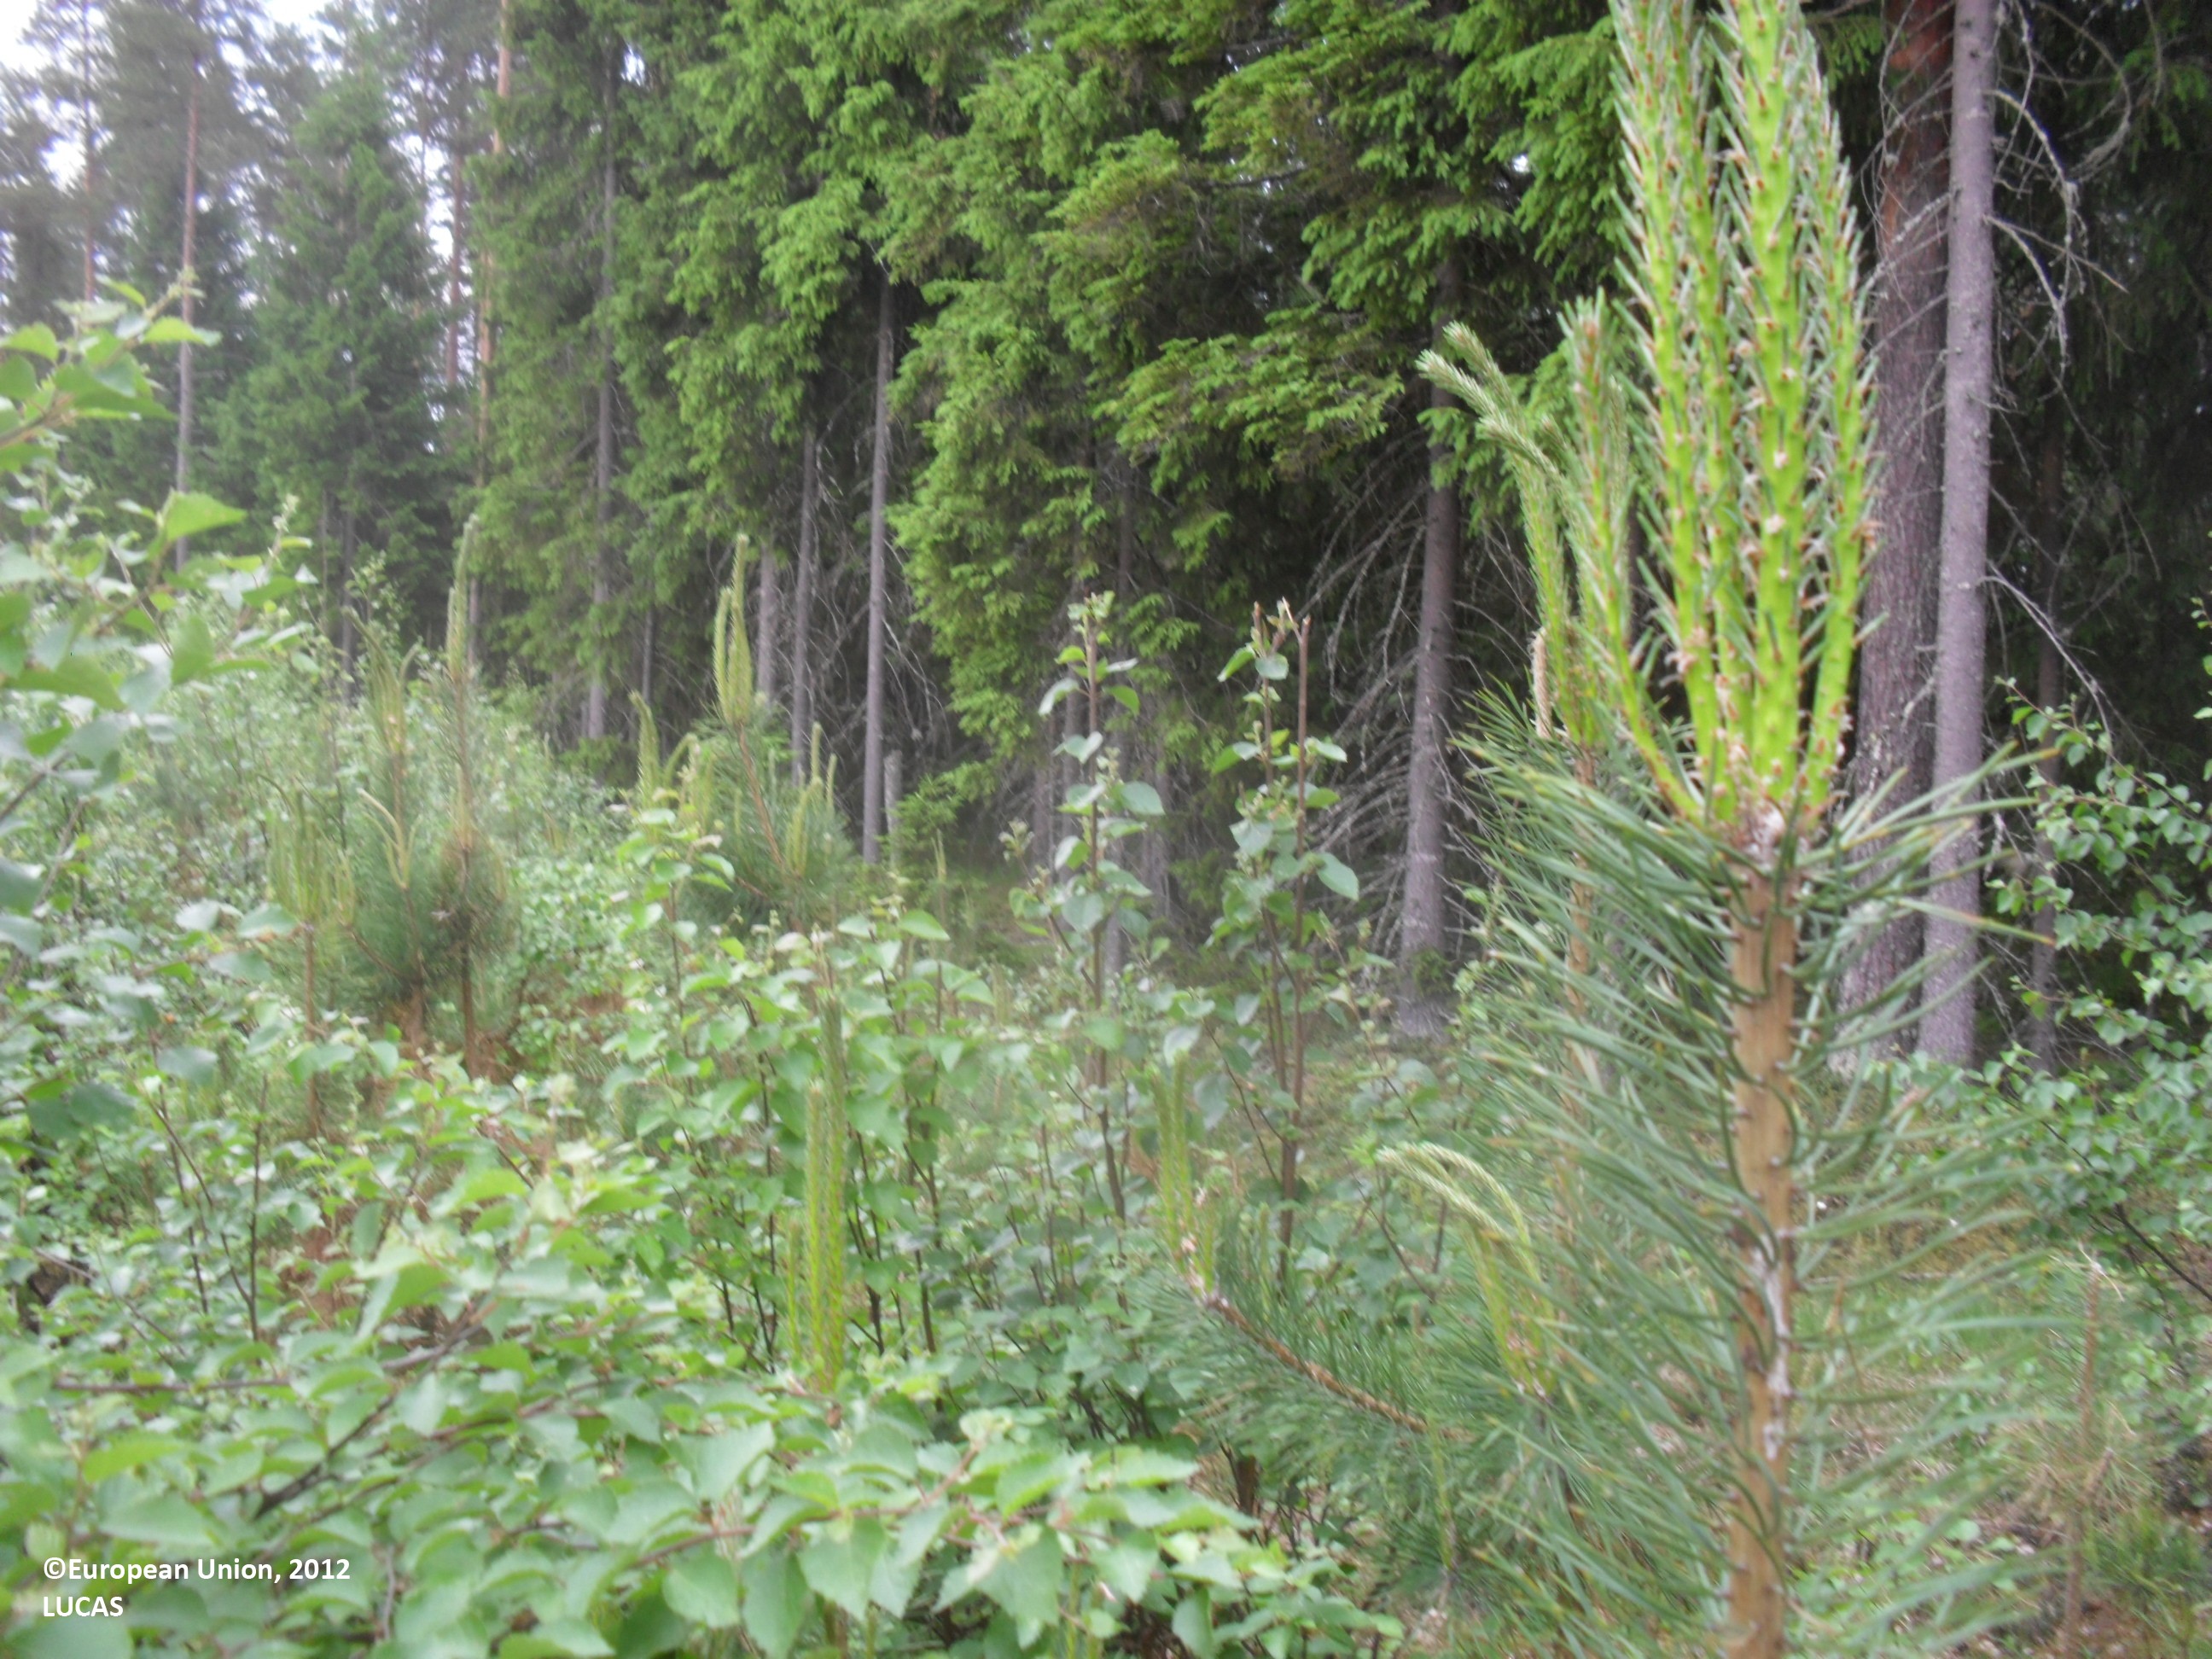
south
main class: Woodland
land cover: Other mixed woodland
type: boreal forest
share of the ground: 50 - 75 %
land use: Forestry
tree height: < 5 m
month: June
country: FI
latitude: 63.4854
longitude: 22.8822
